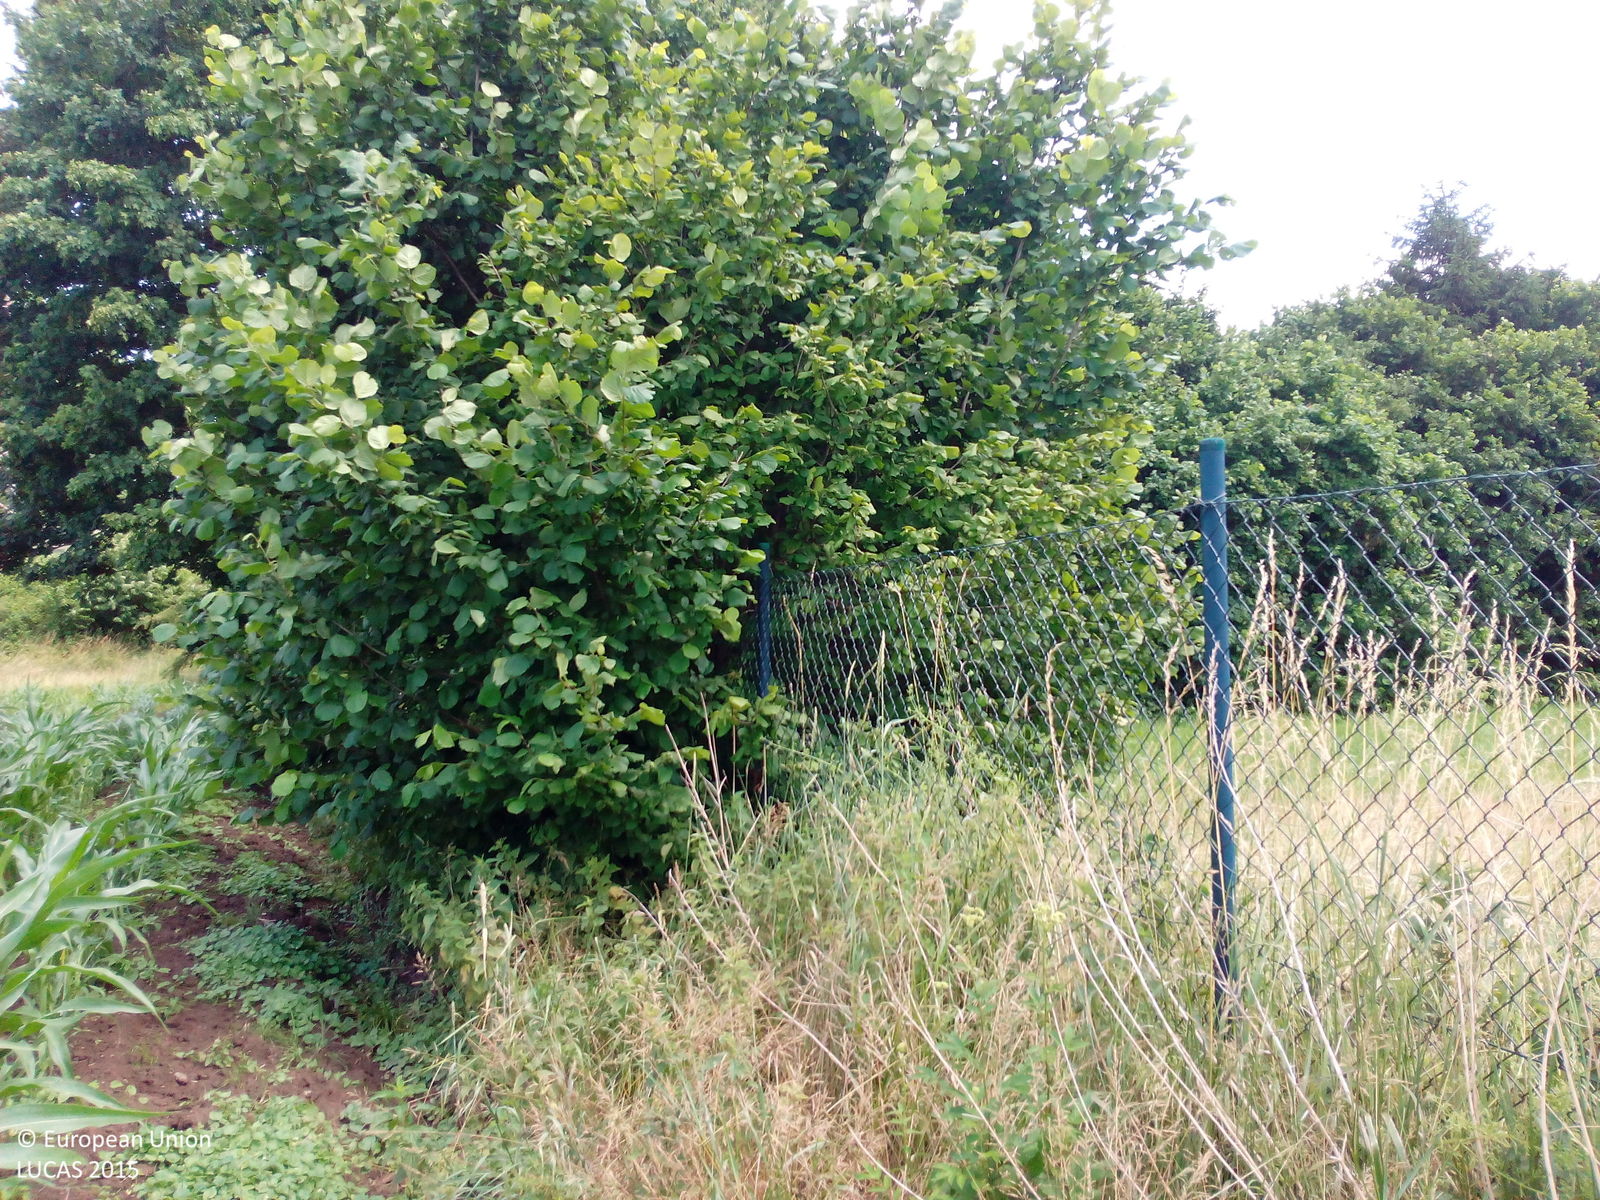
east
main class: Grassland
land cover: Grassland without tree/shrub cover
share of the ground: > 75 %
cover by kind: herbaceous plants 100 %
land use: Sport
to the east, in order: Grassland without tree/shrub cover; Broadleaved woodland; Fences; Grassland without tree/shrub cover; Artificial constructions in urban areas
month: July
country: DE
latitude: 51.8562
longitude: 9.9565
